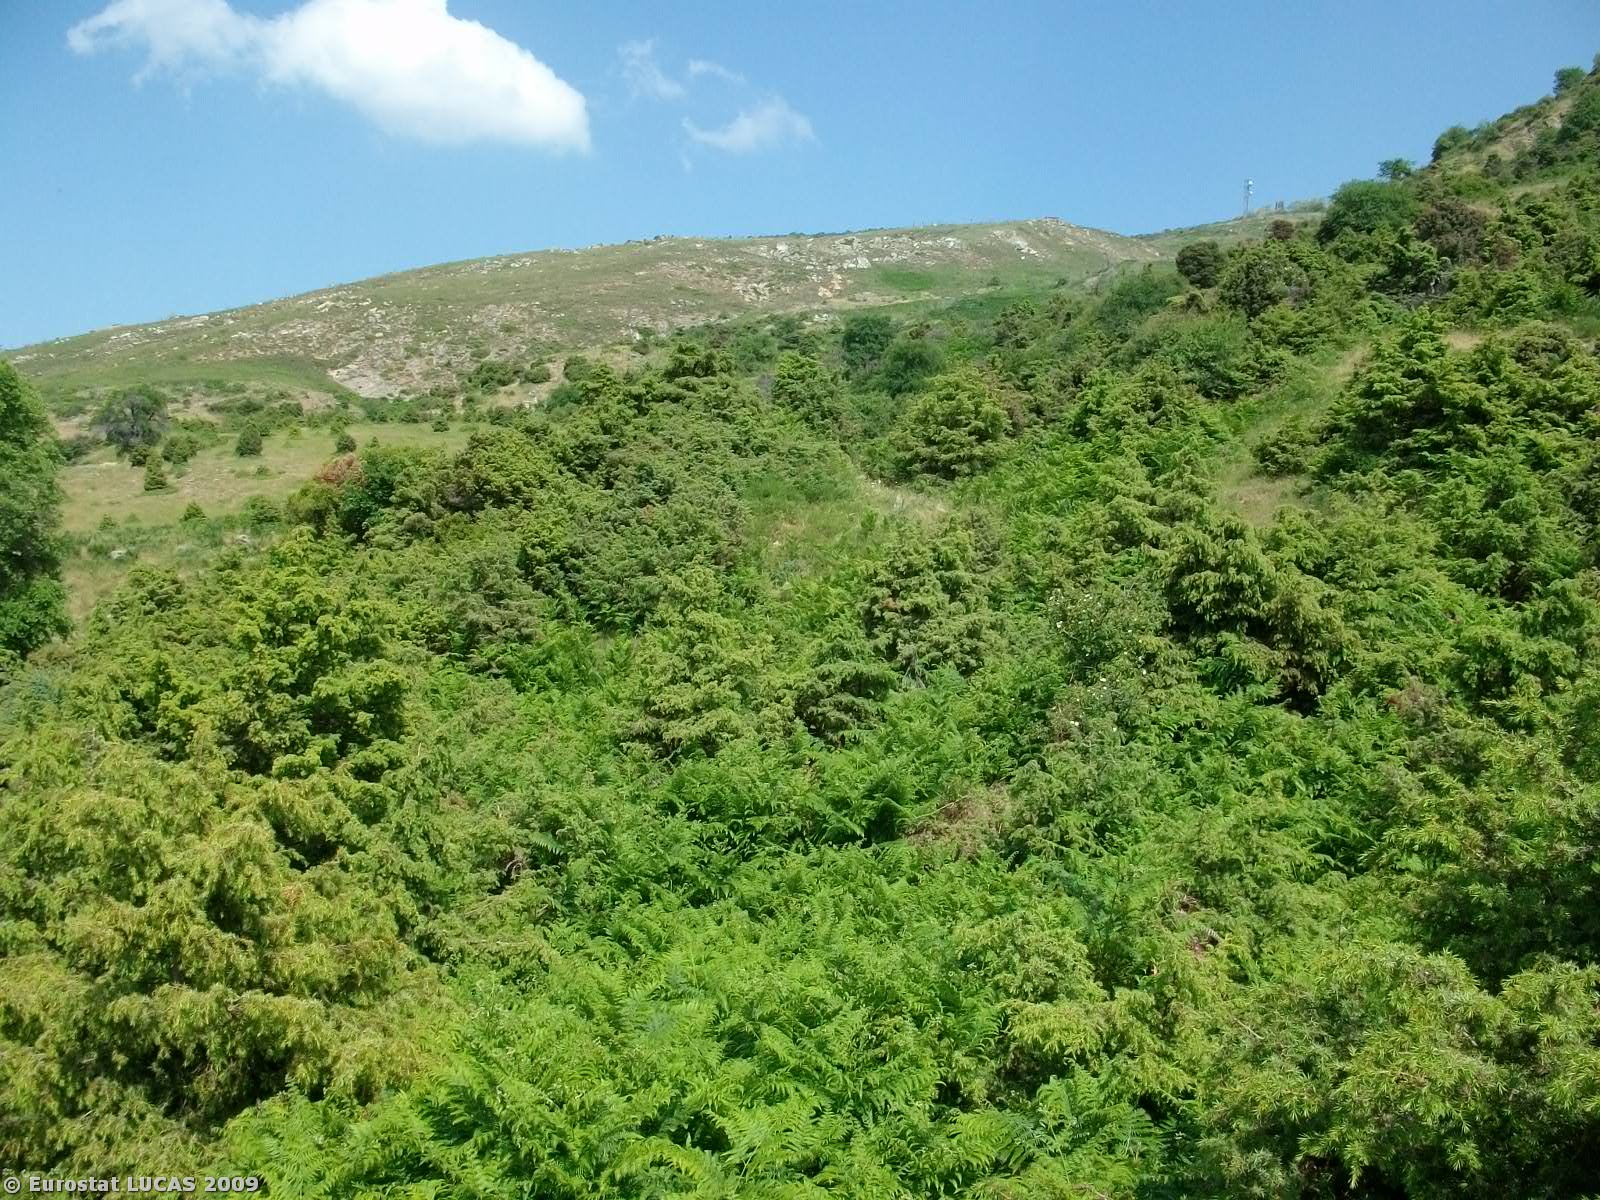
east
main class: Shrubland
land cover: Shrubland with sparse tree cover
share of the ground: > 75 %
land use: Unused
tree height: < 5 m
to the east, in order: Shrubland with sparse tree cover; Grassland with sparse tree/shrub cover; Rivers and streams; Shrubland without tree cover
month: June
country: GR
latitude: 39.8412
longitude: 22.5563
